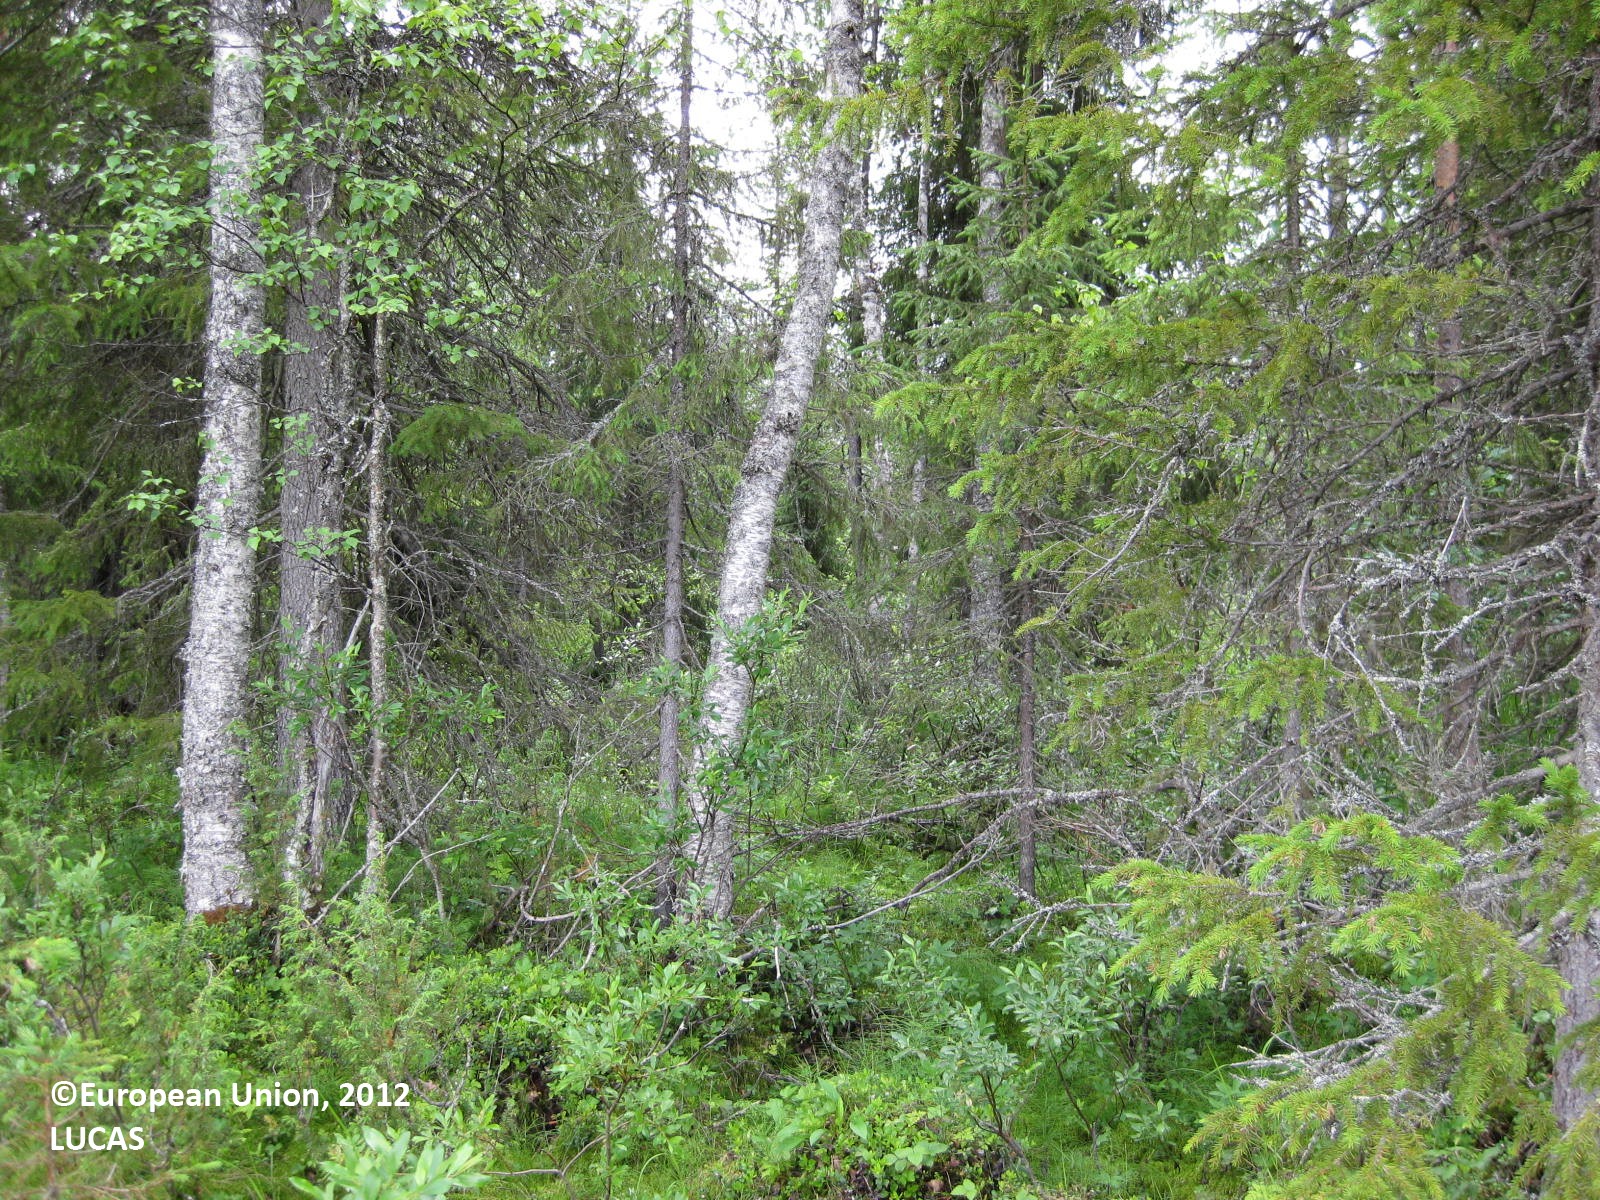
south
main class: Woodland
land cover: Spruce dominated mixed woodland
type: boreal forest
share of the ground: 50 - 75 %
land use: Forestry
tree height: < 5 m
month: July
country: FI
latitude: 65.5617
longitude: 28.2847
